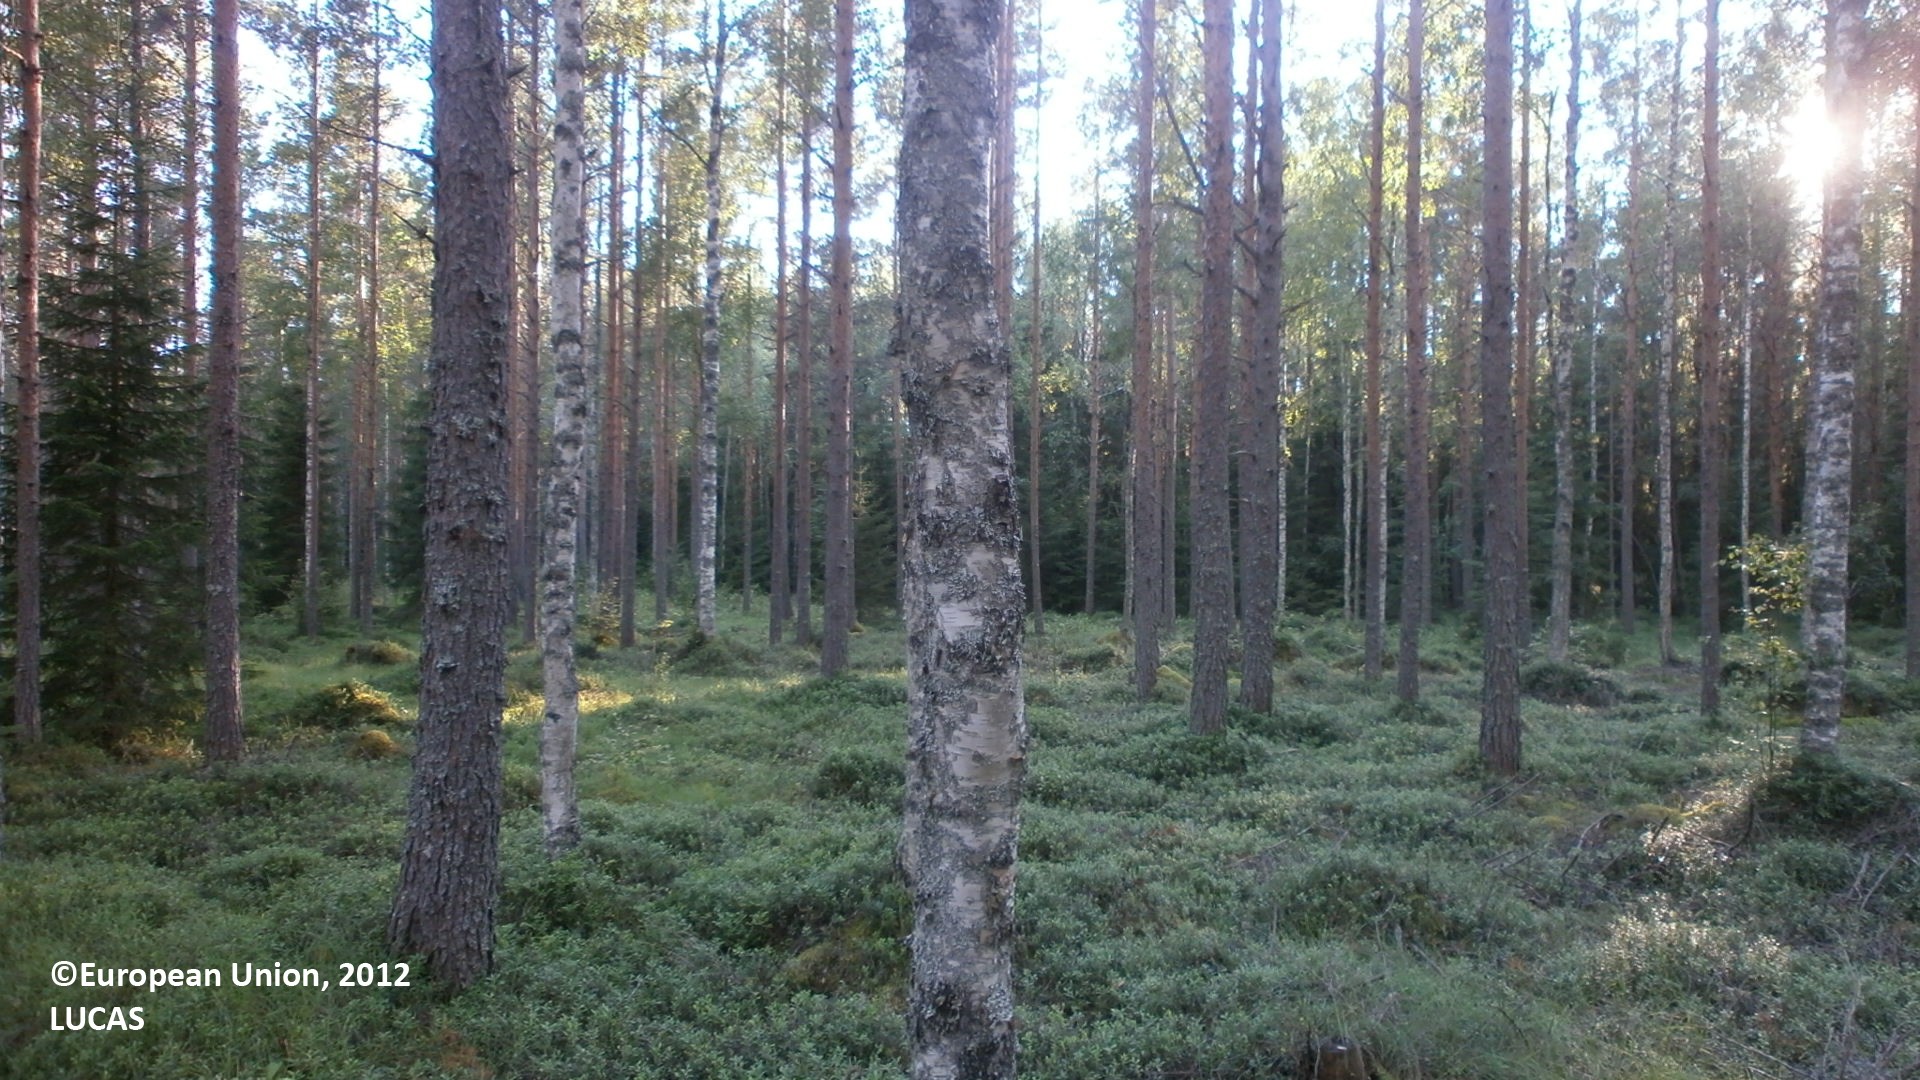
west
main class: Woodland
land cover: Pine dominated mixed woodland
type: boreal forest
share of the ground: 50 - 75 %
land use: Forestry
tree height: > 5 m
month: July
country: FI
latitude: 64.0484
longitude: 24.0129
